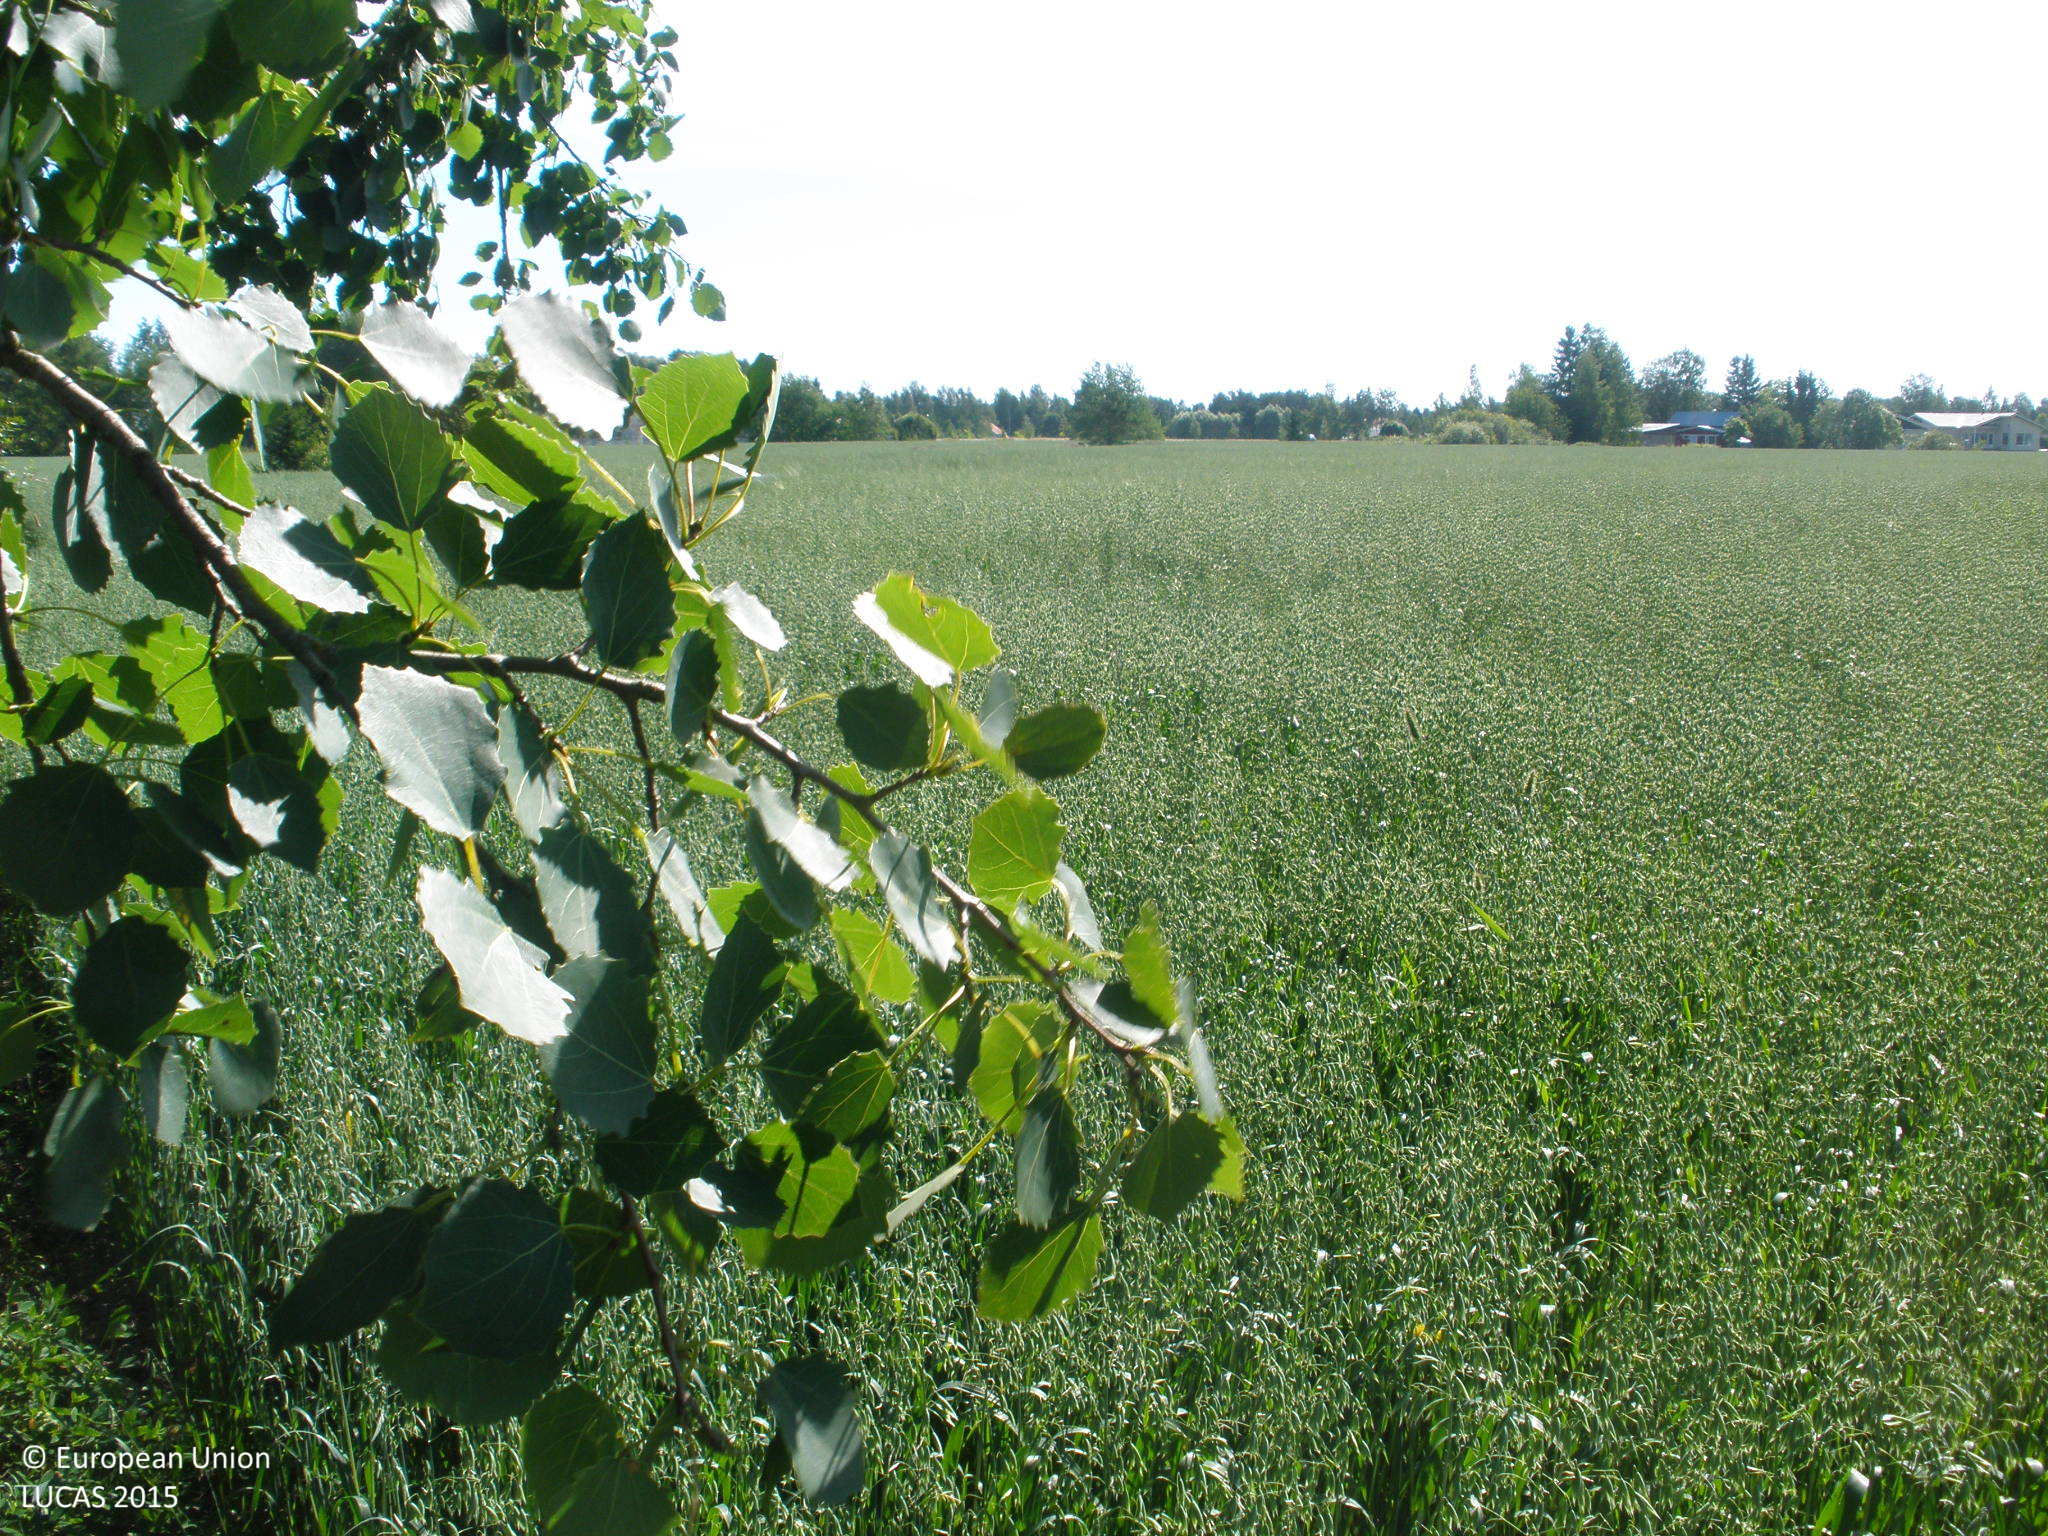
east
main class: Cropland
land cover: Oats
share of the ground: 50 - 75 %
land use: Agriculture (excluding fallow land and kitchen gardens)
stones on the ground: < 10 %
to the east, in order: Oats; Grass margins; Ditches and canals; Grass margins; Oats
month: August
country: FI
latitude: 60.6614
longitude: 23.1245
